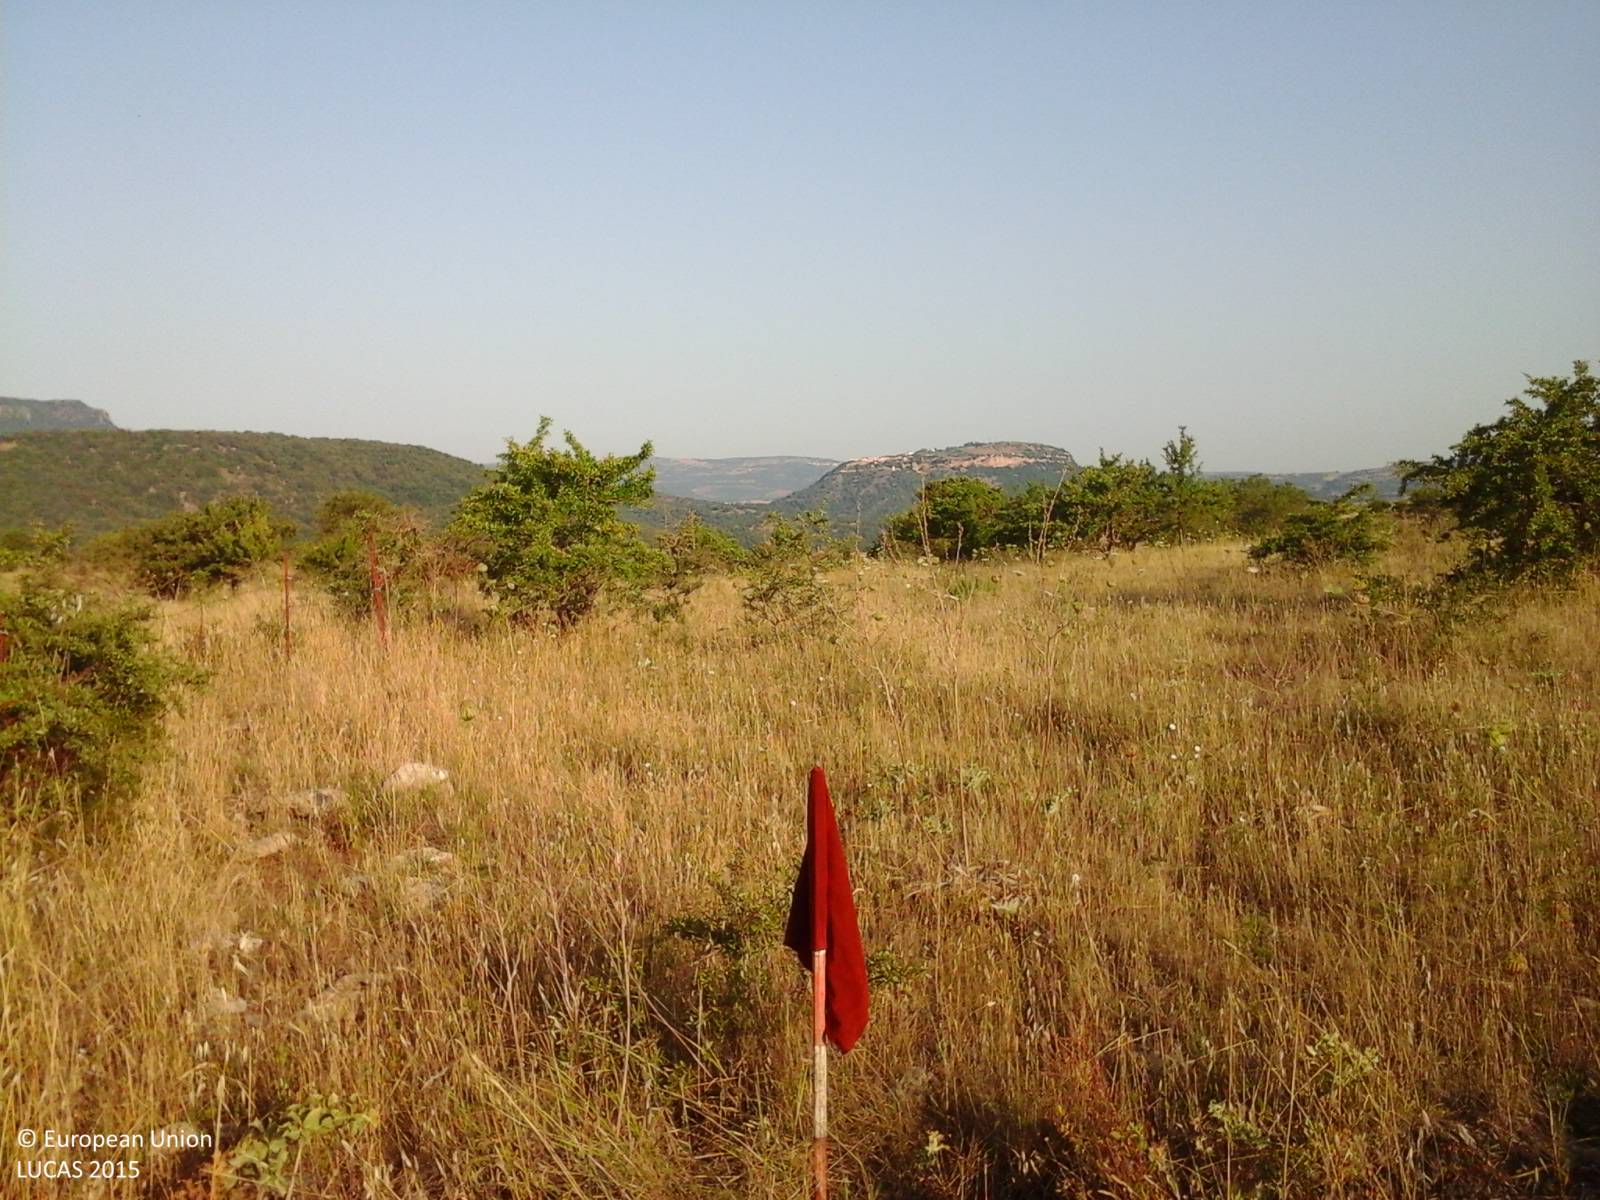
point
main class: Grassland
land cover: Grassland with sparse tree/shrub cover
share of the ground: > 75 %
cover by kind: herbaceous plants 90 %, broadleaved forest trees 5 %, shrubs 5 %
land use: Agriculture (excluding fallow land and kitchen gardens)
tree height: < 5 m
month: July
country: IT
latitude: 40.4565
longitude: 8.6038
